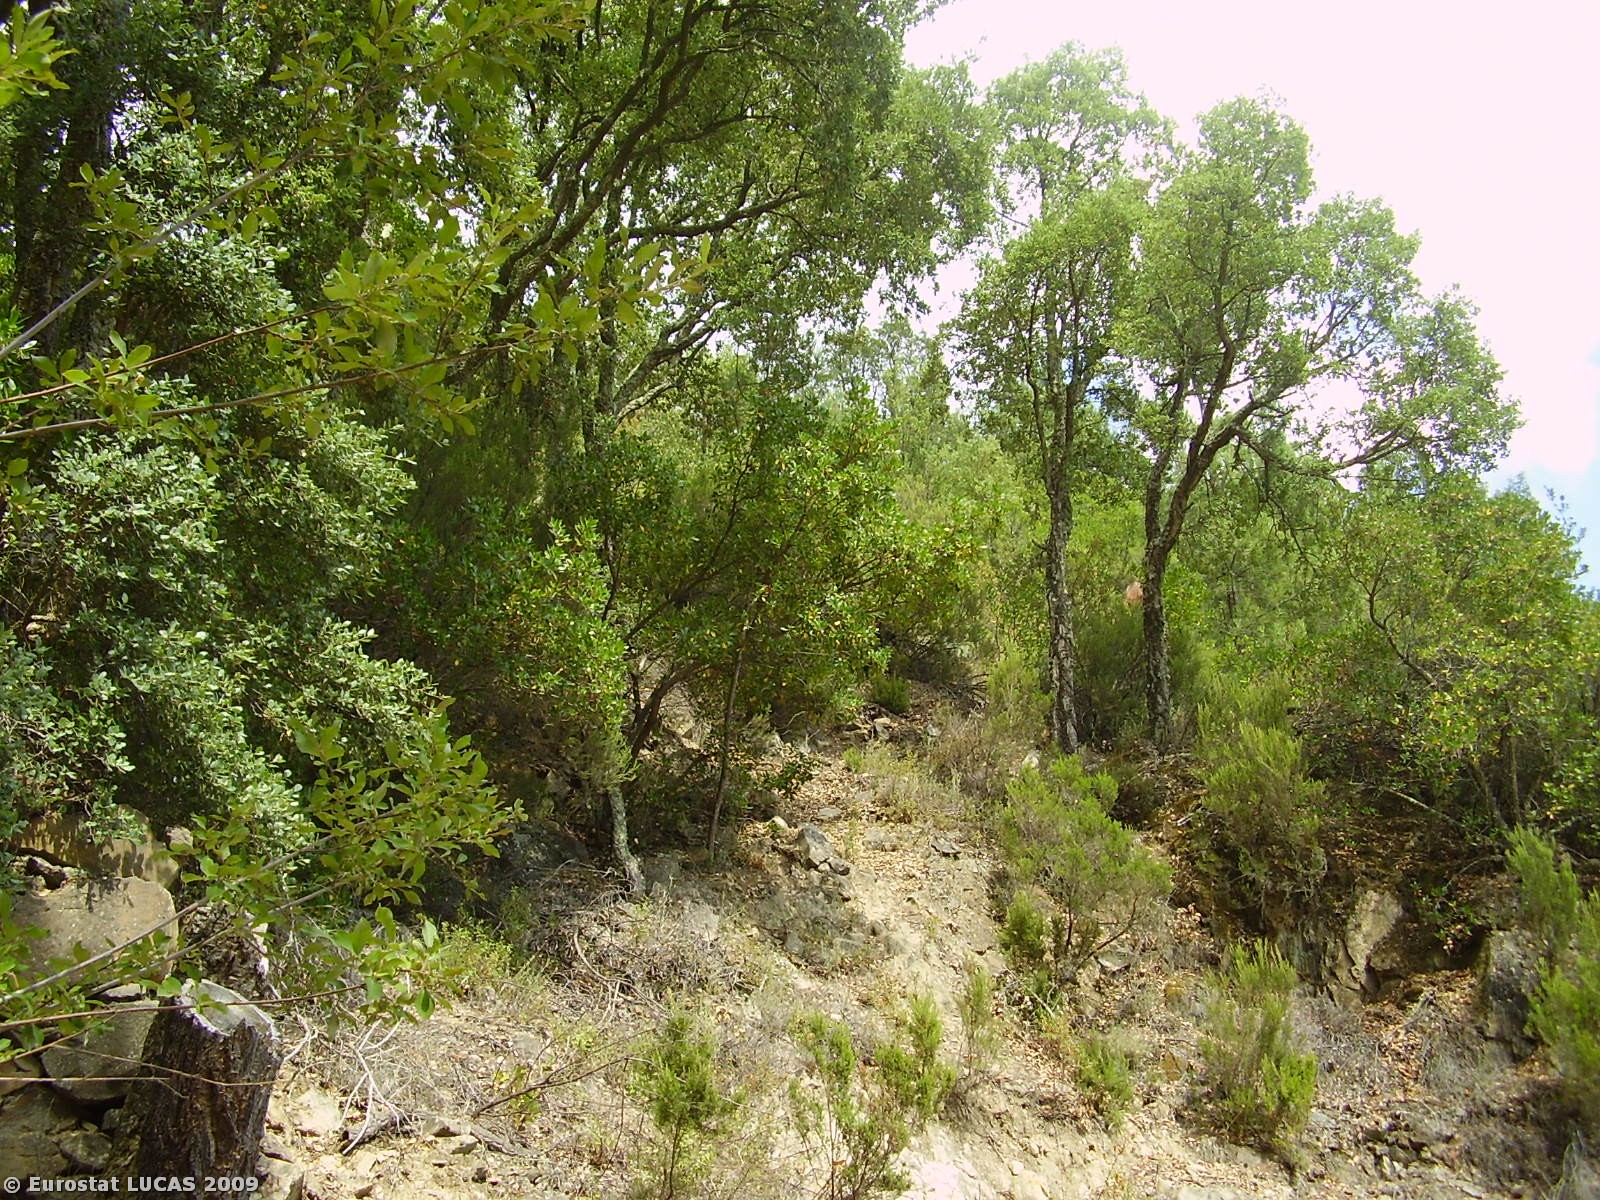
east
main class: Woodland
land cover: Broadleaved woodland
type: broadleaved evergreen forest
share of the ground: > 75 %
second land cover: Spontaneously vegetated surfaces
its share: 10 - 25 %
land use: Unused
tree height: > 5 m
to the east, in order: Broadleaved woodland; Spontaneously vegetated surfaces; Broadleaved woodland; Tracks; Other structural elements; Broadleaved woodland; Tracks; Other structural elements; Broadleaved woodland; Tracks; Other structural elements; Broadleaved woodland
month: July
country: PT
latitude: 41.2188
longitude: -7.6490
